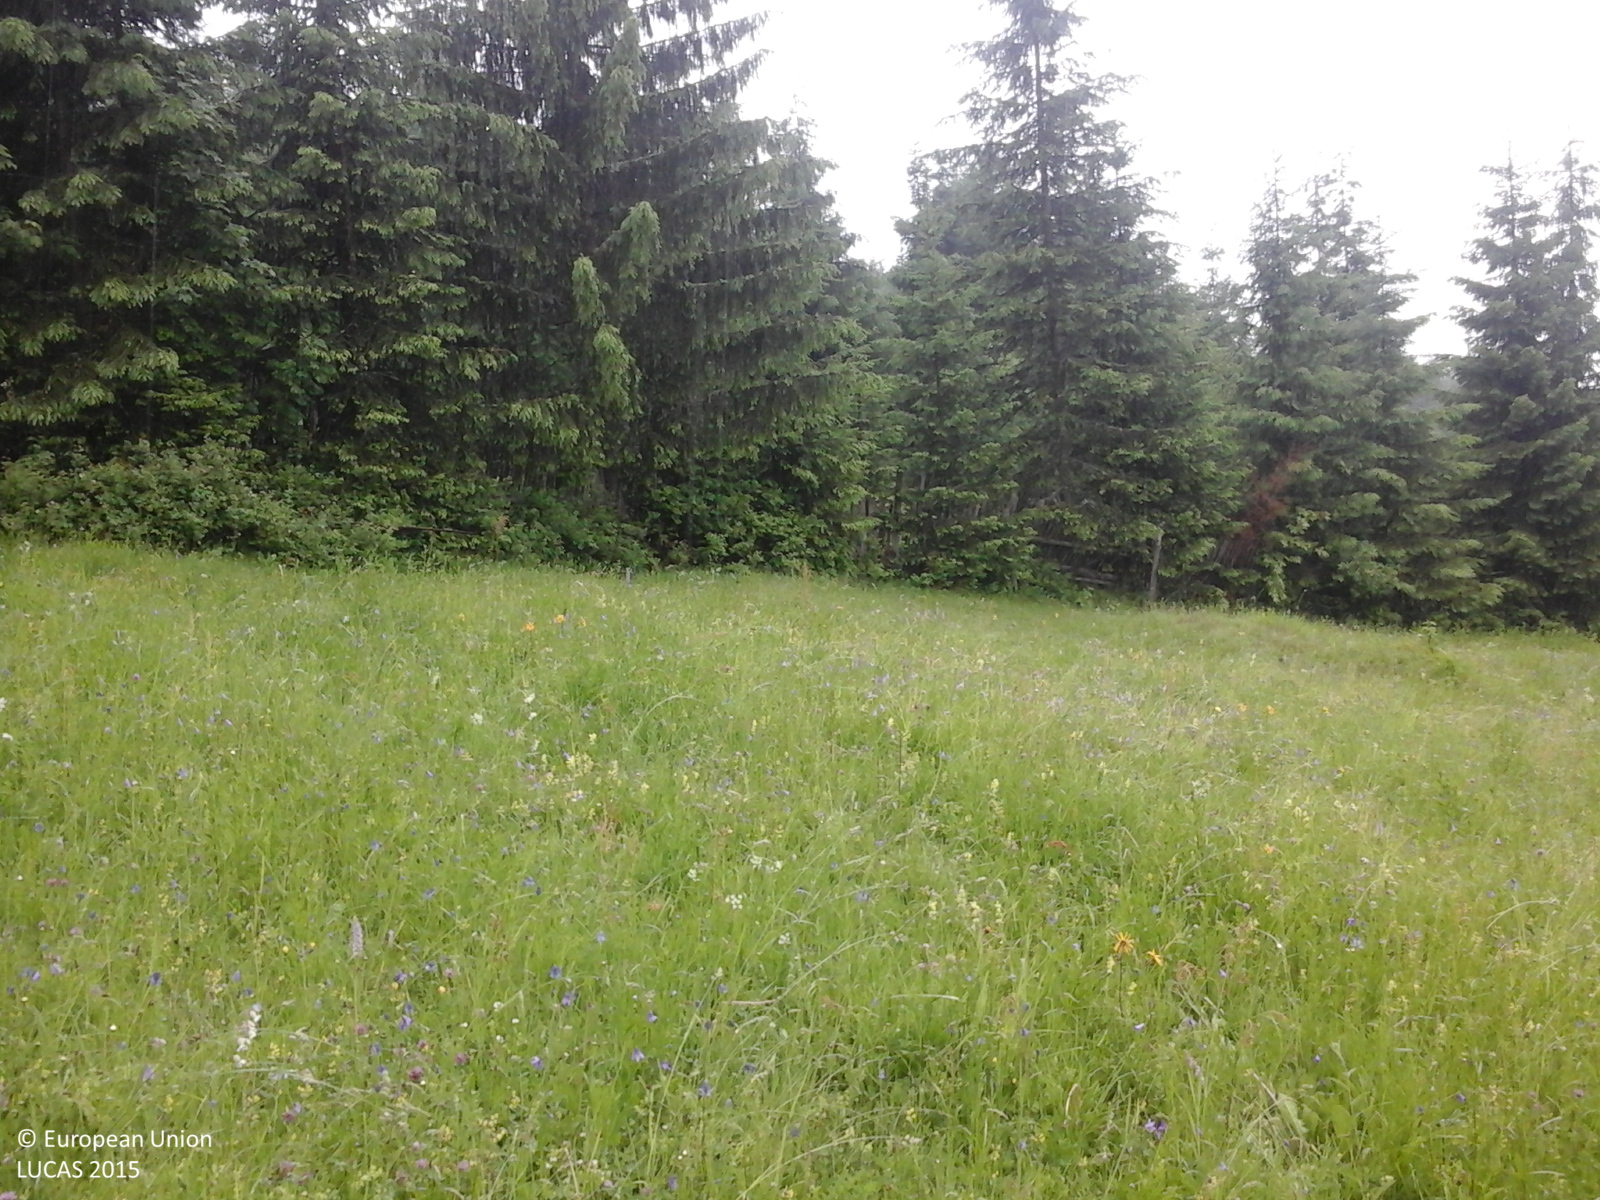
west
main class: Grassland
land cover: Grassland without tree/shrub cover
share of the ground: > 75 %
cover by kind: herbaceous plants 100 %
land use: Agriculture (excluding fallow land and kitchen gardens)
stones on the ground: < 10 %
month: June
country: RO
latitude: 47.2156
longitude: 25.3346
